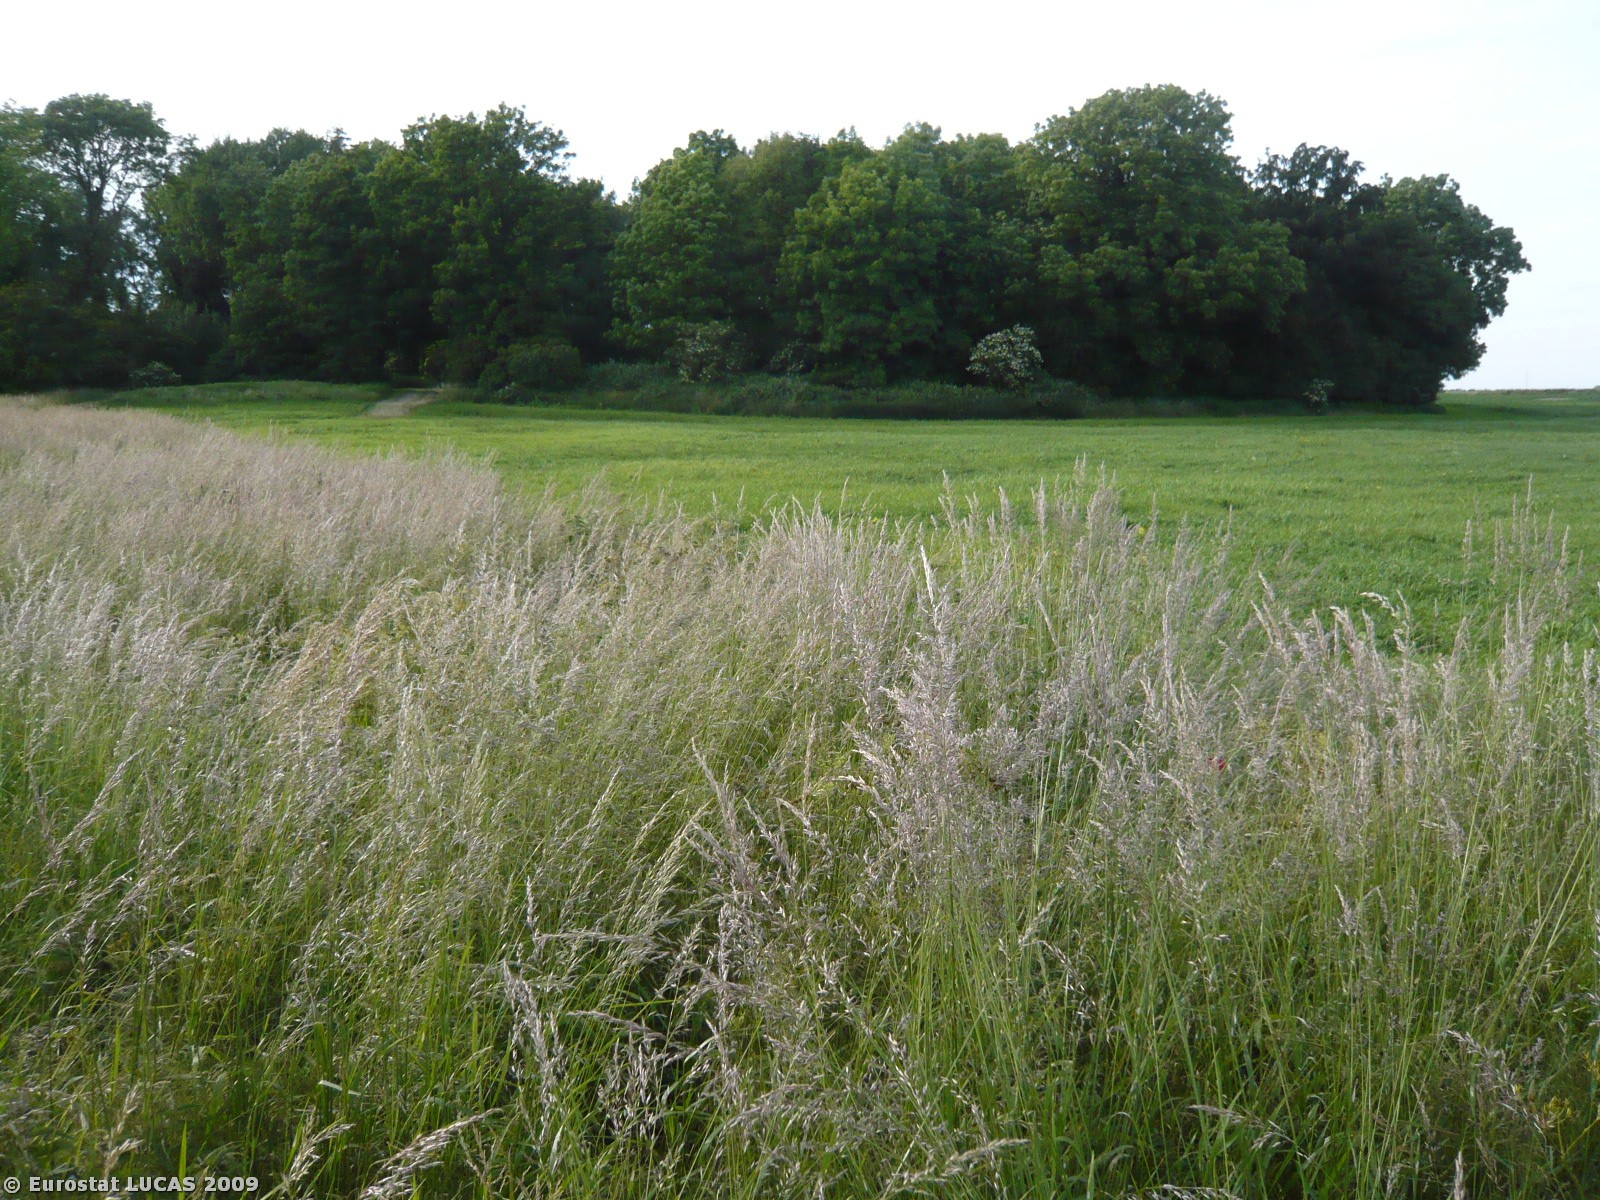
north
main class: Grassland
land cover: Grassland without tree/shrub cover
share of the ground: > 75 %
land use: Unused
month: June
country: DK
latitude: 54.8340
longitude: 11.1979
